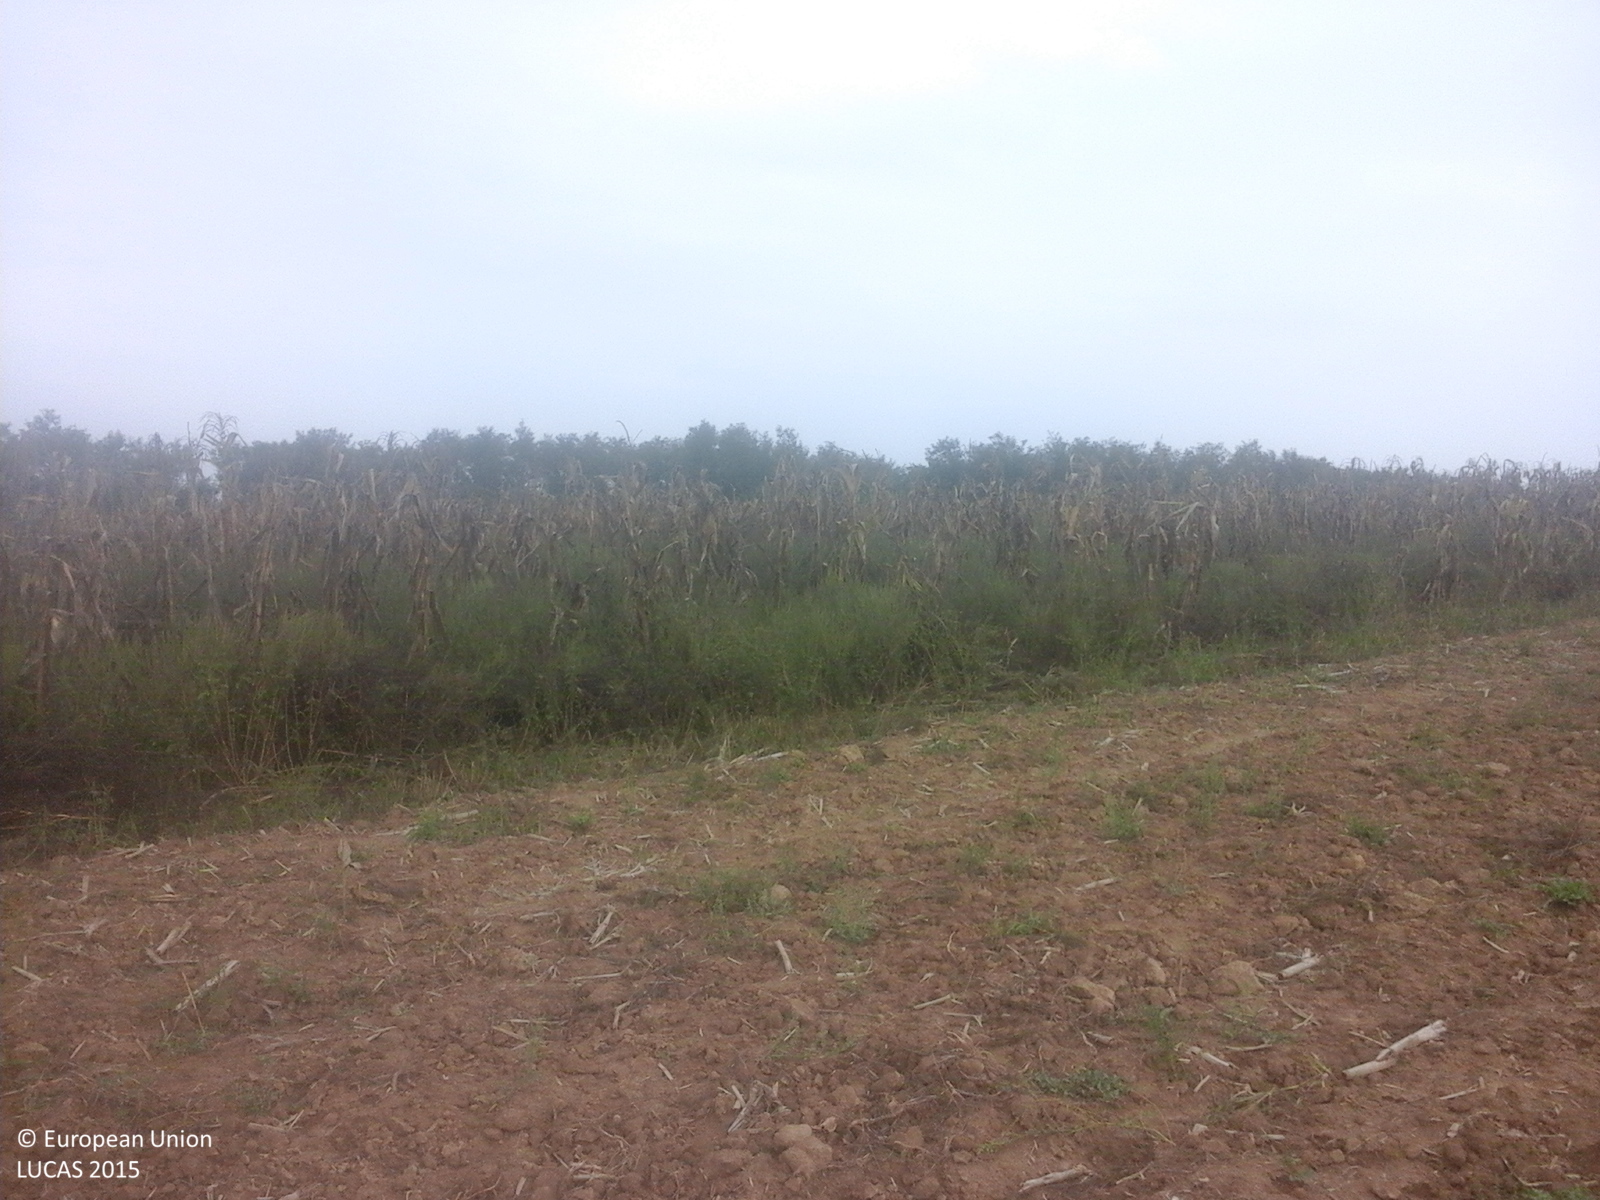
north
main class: Cropland
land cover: Potatoes
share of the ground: < 10 %
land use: Agriculture (excluding fallow land and kitchen gardens)
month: September
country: RO
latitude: 45.8339
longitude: 22.1832
